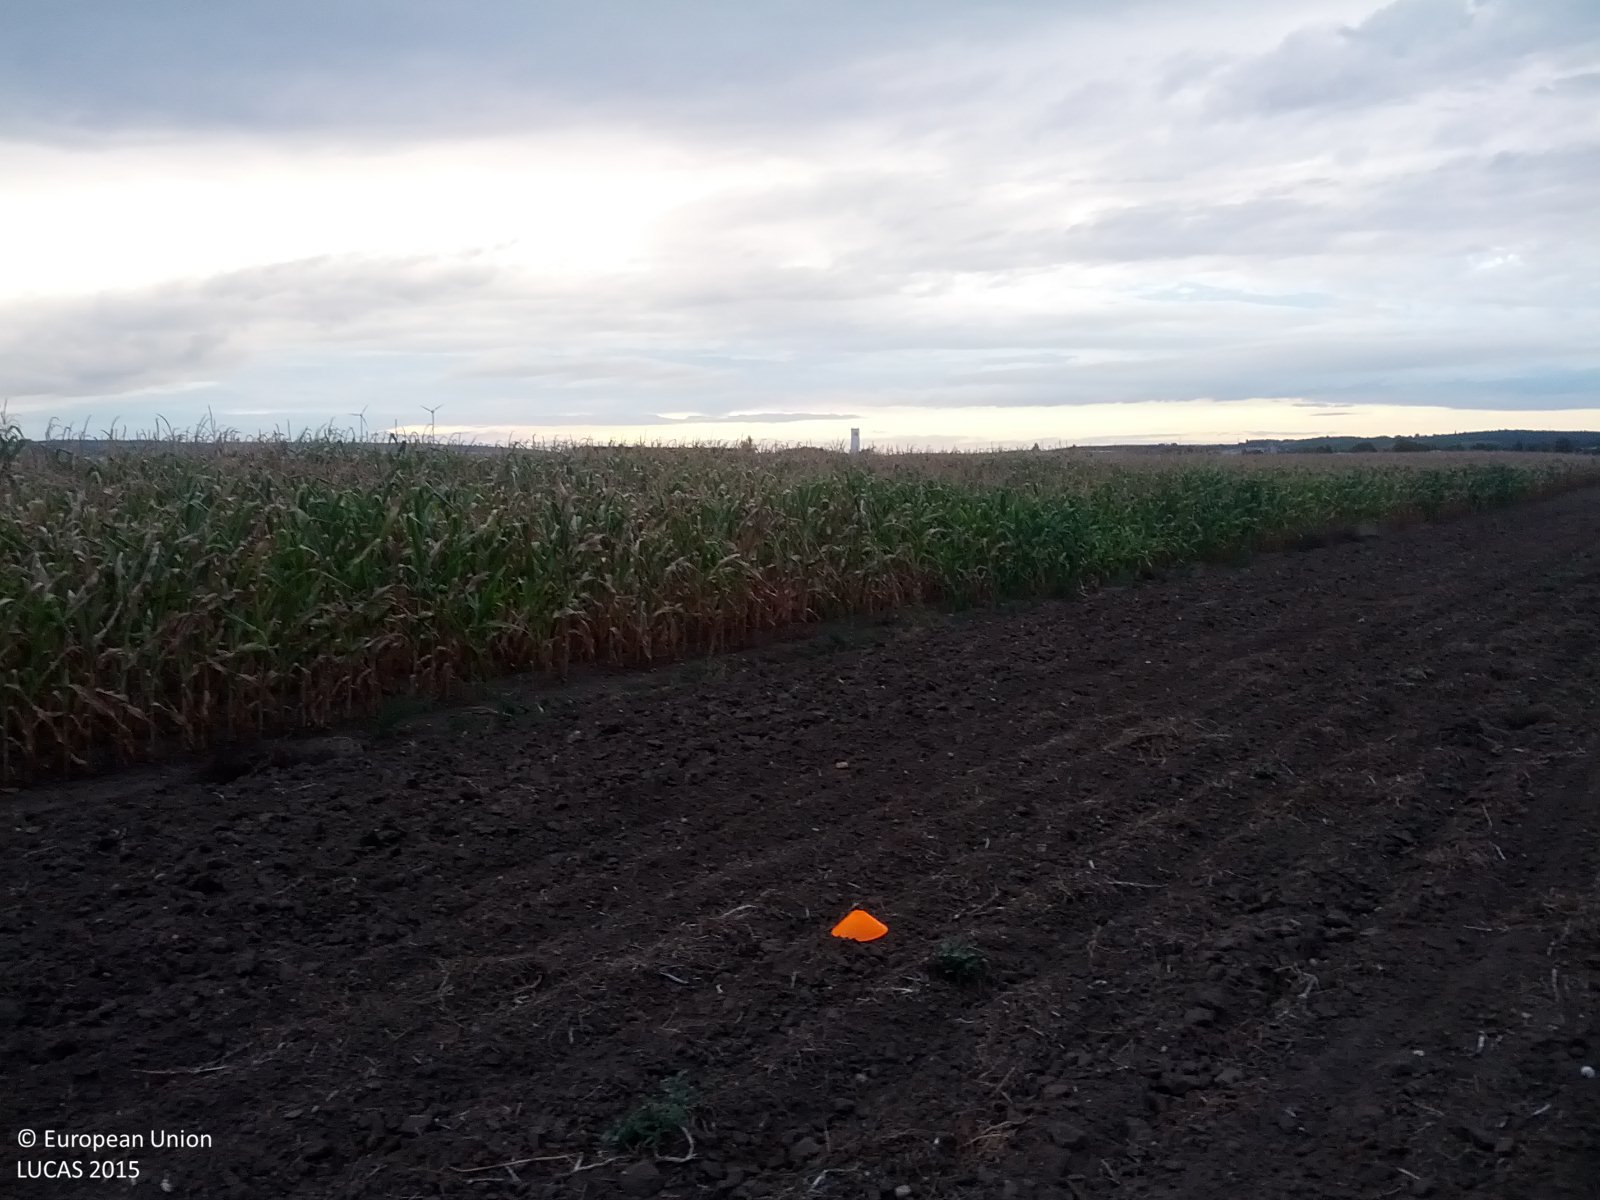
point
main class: Cropland
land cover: Other root crops
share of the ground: < 10 %
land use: Agriculture (excluding fallow land and kitchen gardens)
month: July
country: AT
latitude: 48.3552
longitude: 16.5241
